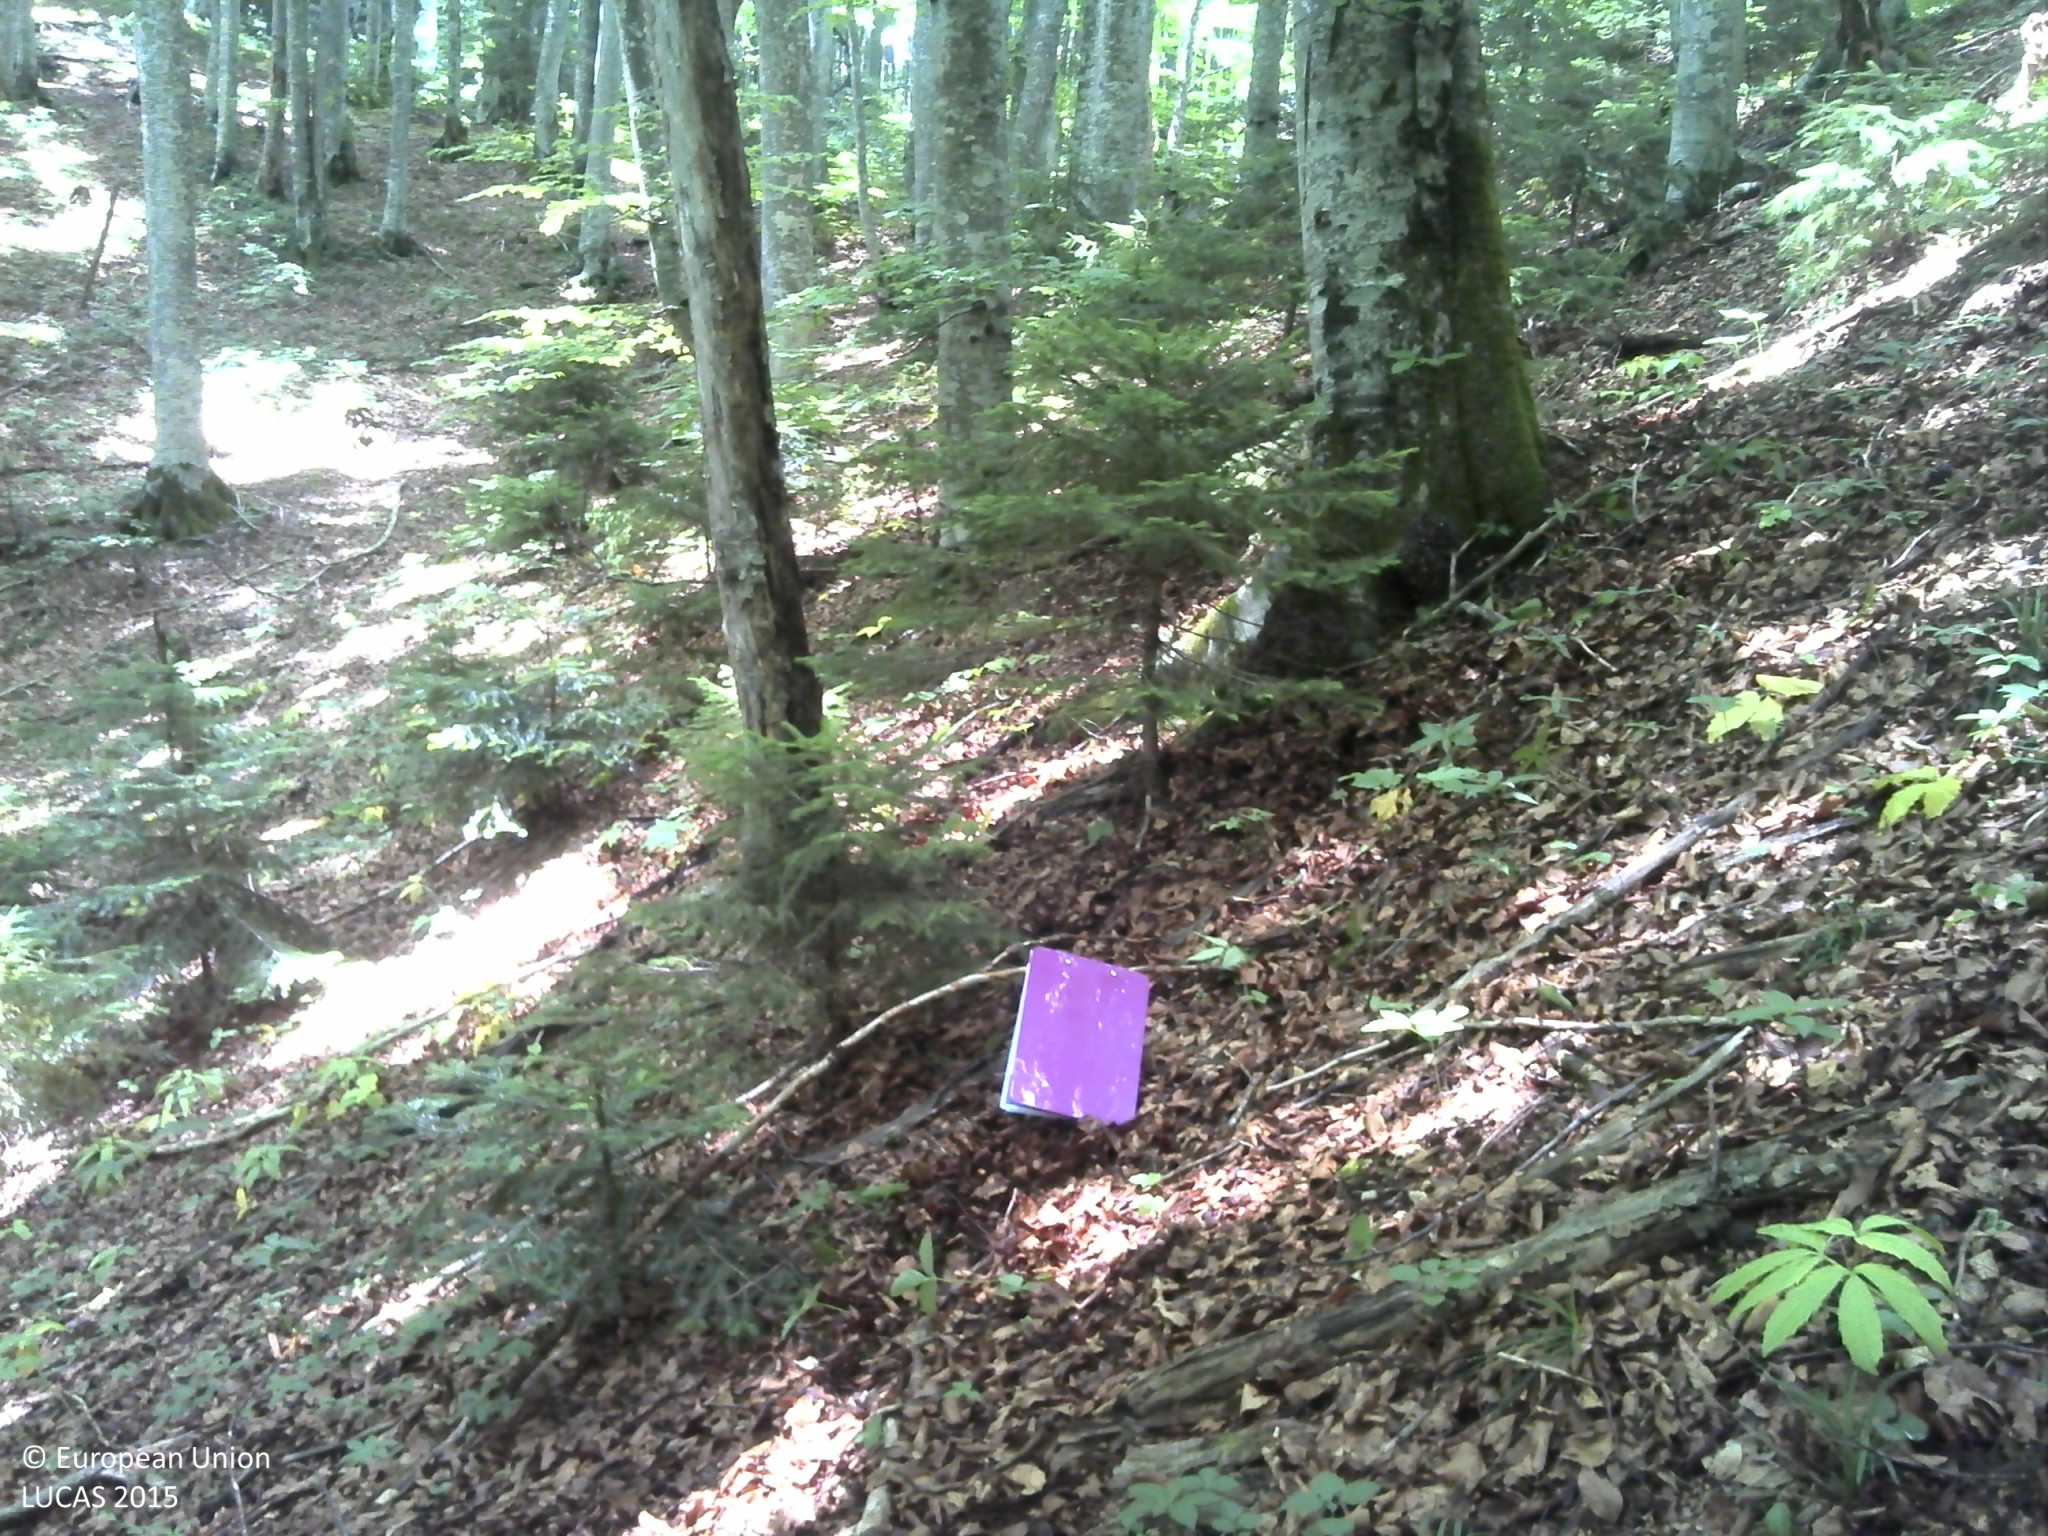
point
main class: Woodland
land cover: Broadleaved woodland
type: beech forest
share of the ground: > 75 %
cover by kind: broadleaved forest trees 90 %, coniferous forest trees 5 %, shrubs 5 %
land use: Forestry
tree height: > 5 m
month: June
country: HR
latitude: 44.8293
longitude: 15.6483
